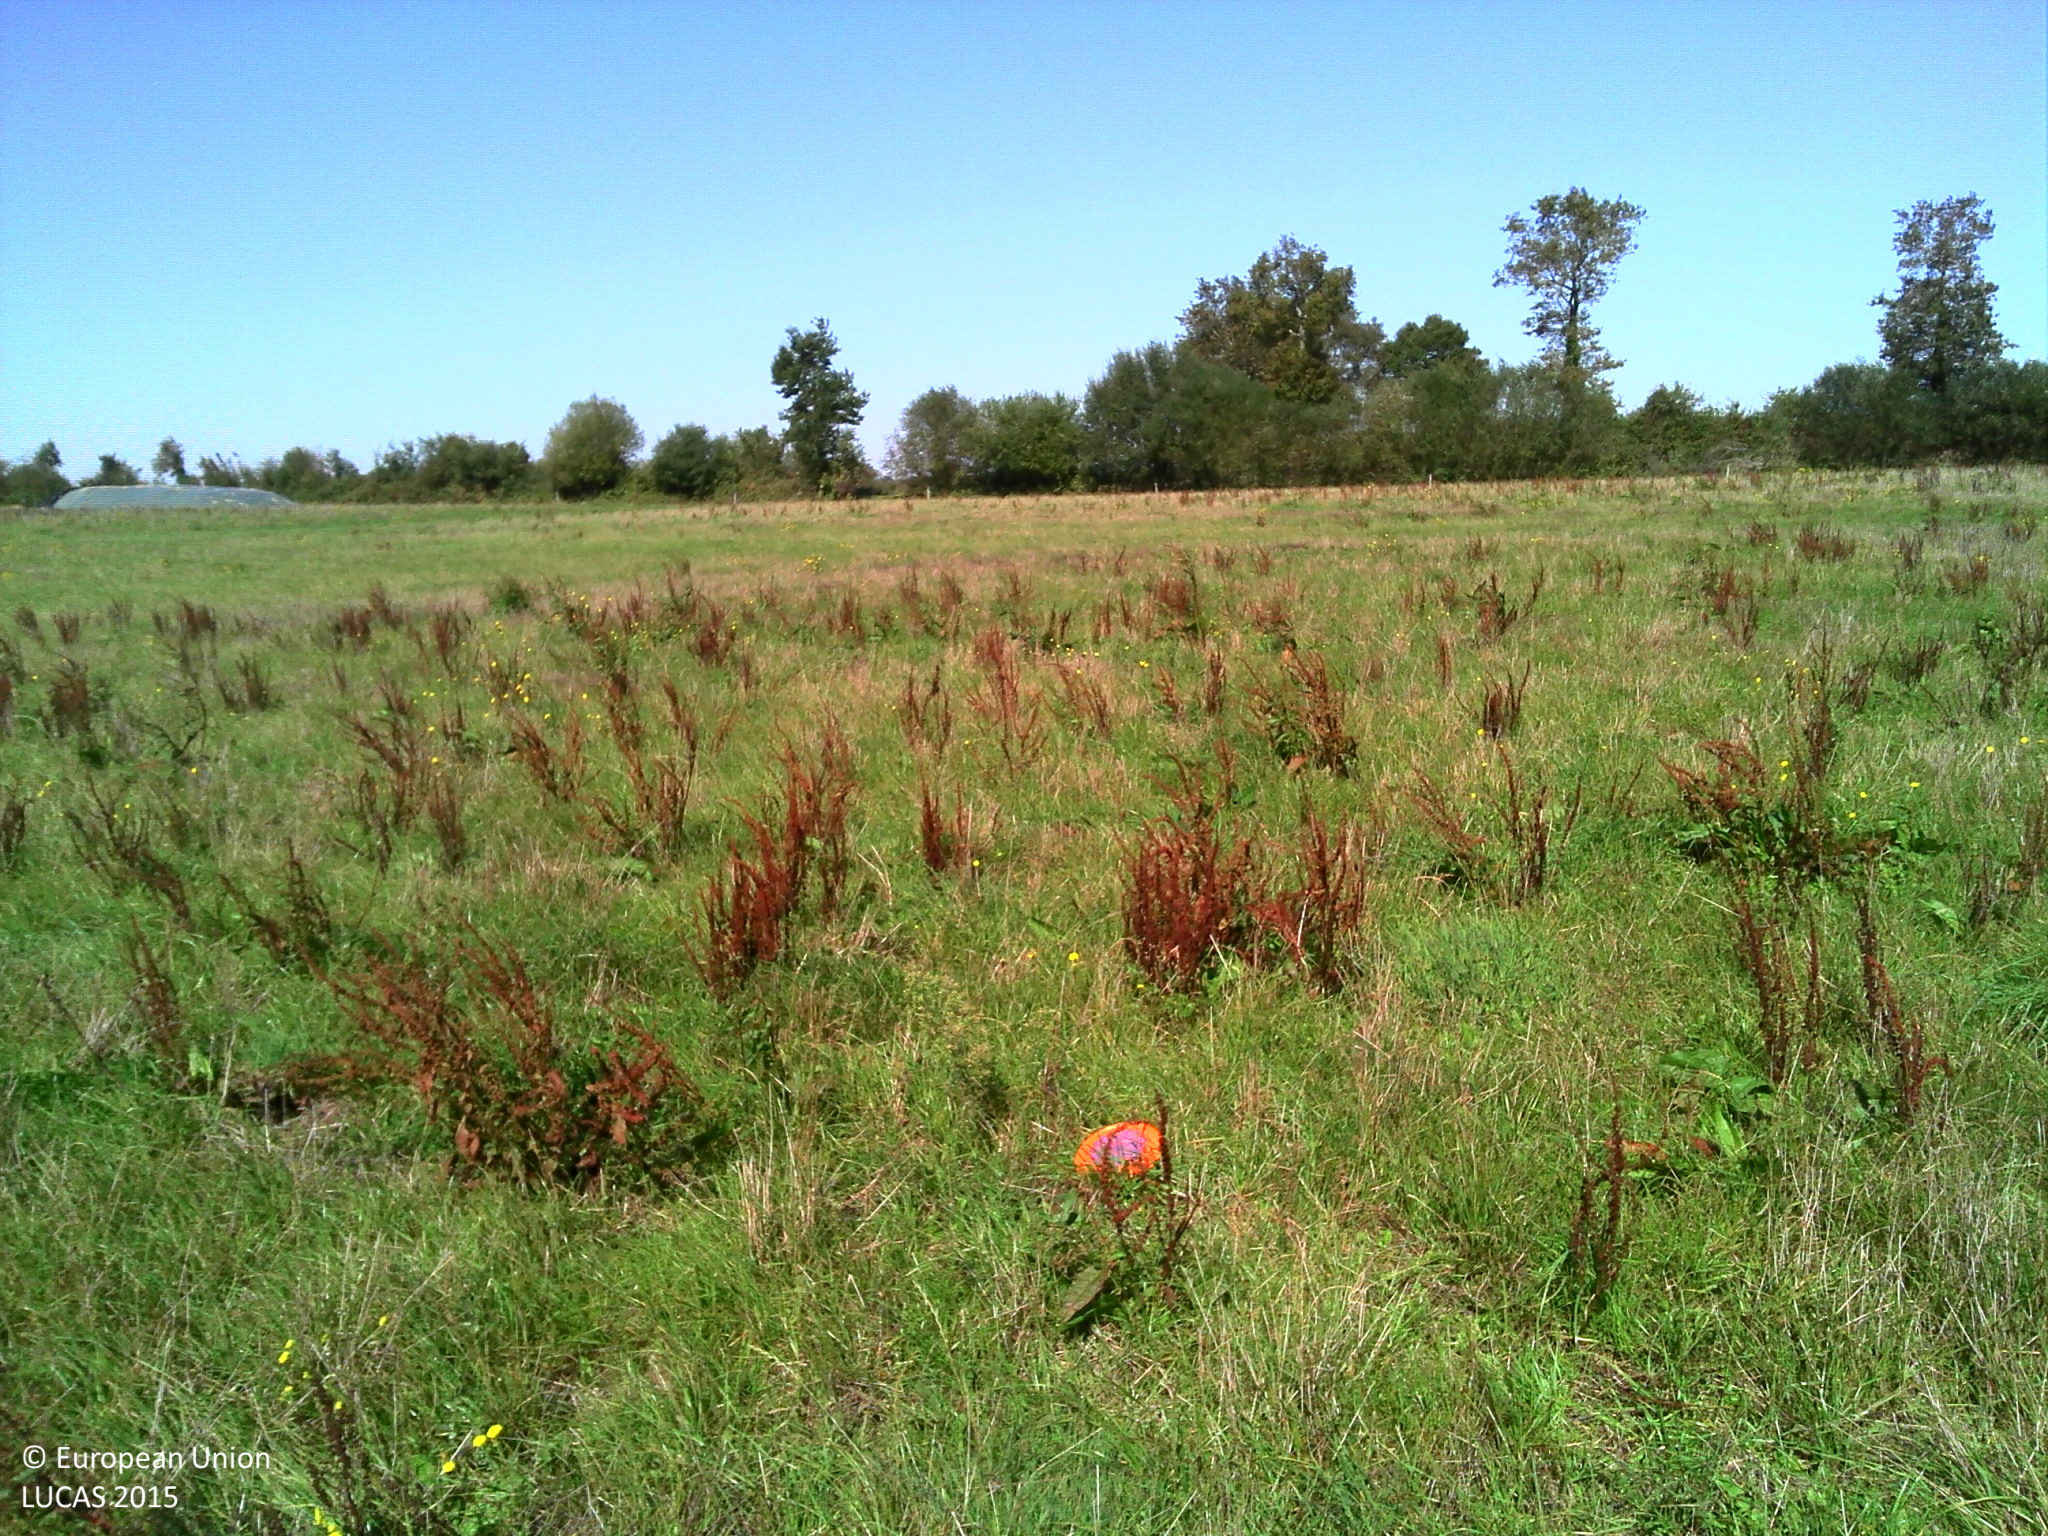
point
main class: Grassland
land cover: Grassland without tree/shrub cover
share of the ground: > 75 %
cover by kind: herbaceous plants 100 %
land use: Agriculture (excluding fallow land and kitchen gardens)
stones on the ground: < 10 %
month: September
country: FR
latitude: 46.6044
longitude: -1.3026
